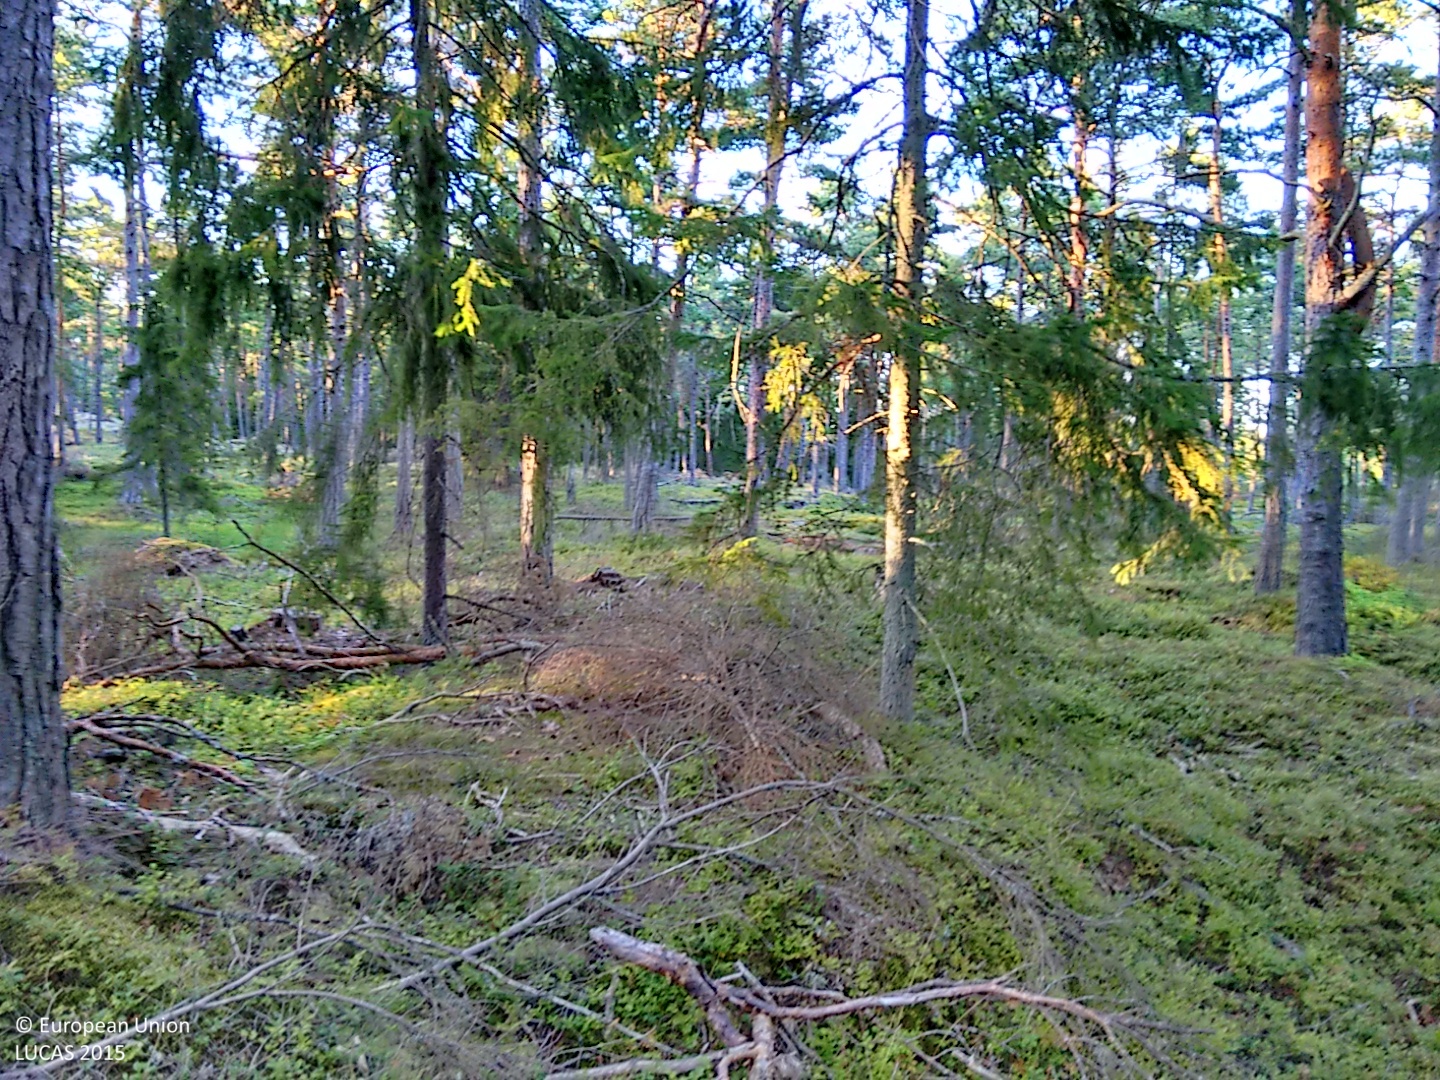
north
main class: Woodland
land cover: Pine dominated coniferous woodland
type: hemiboreal forest and nemoral coniferous forest and mixed broadleaved-coniferous forest
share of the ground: > 75 %
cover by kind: coniferous forest trees 90 %, shrubs 10 %
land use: Forestry
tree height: > 5 m
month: August
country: FI
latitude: 60.1157
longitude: 19.9934
